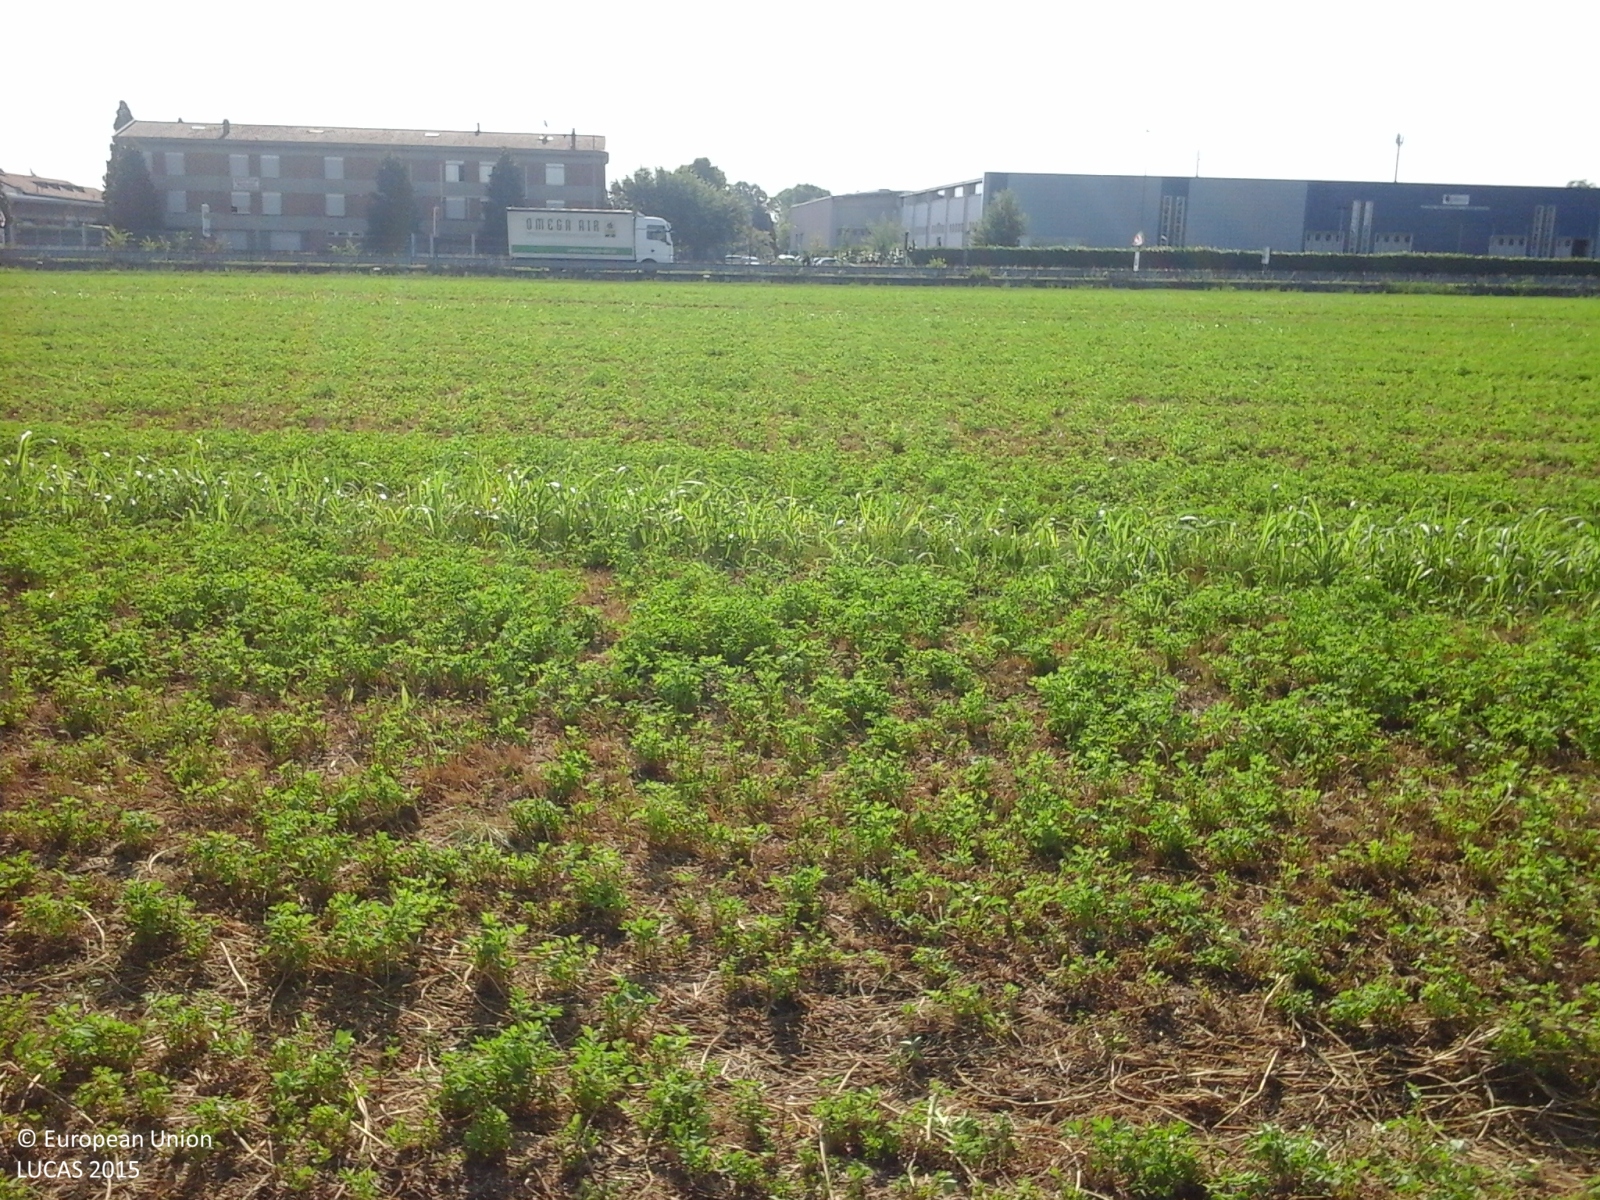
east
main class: Cropland
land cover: Lucerne
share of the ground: > 75 %
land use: Agriculture (excluding fallow land and kitchen gardens)
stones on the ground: < 10 %
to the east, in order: Lucerne; Ditches and canals; Lucerne; Ditches and canals; Lucerne; Grass margins; Inland fresh running water; Paved roads, cycling and walking lanes; Grass margins; Ditches and canals; Grassland without tree/shrub cover; Artificial constructions in urban areas
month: June
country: IT
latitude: 44.5985
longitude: 10.9680
